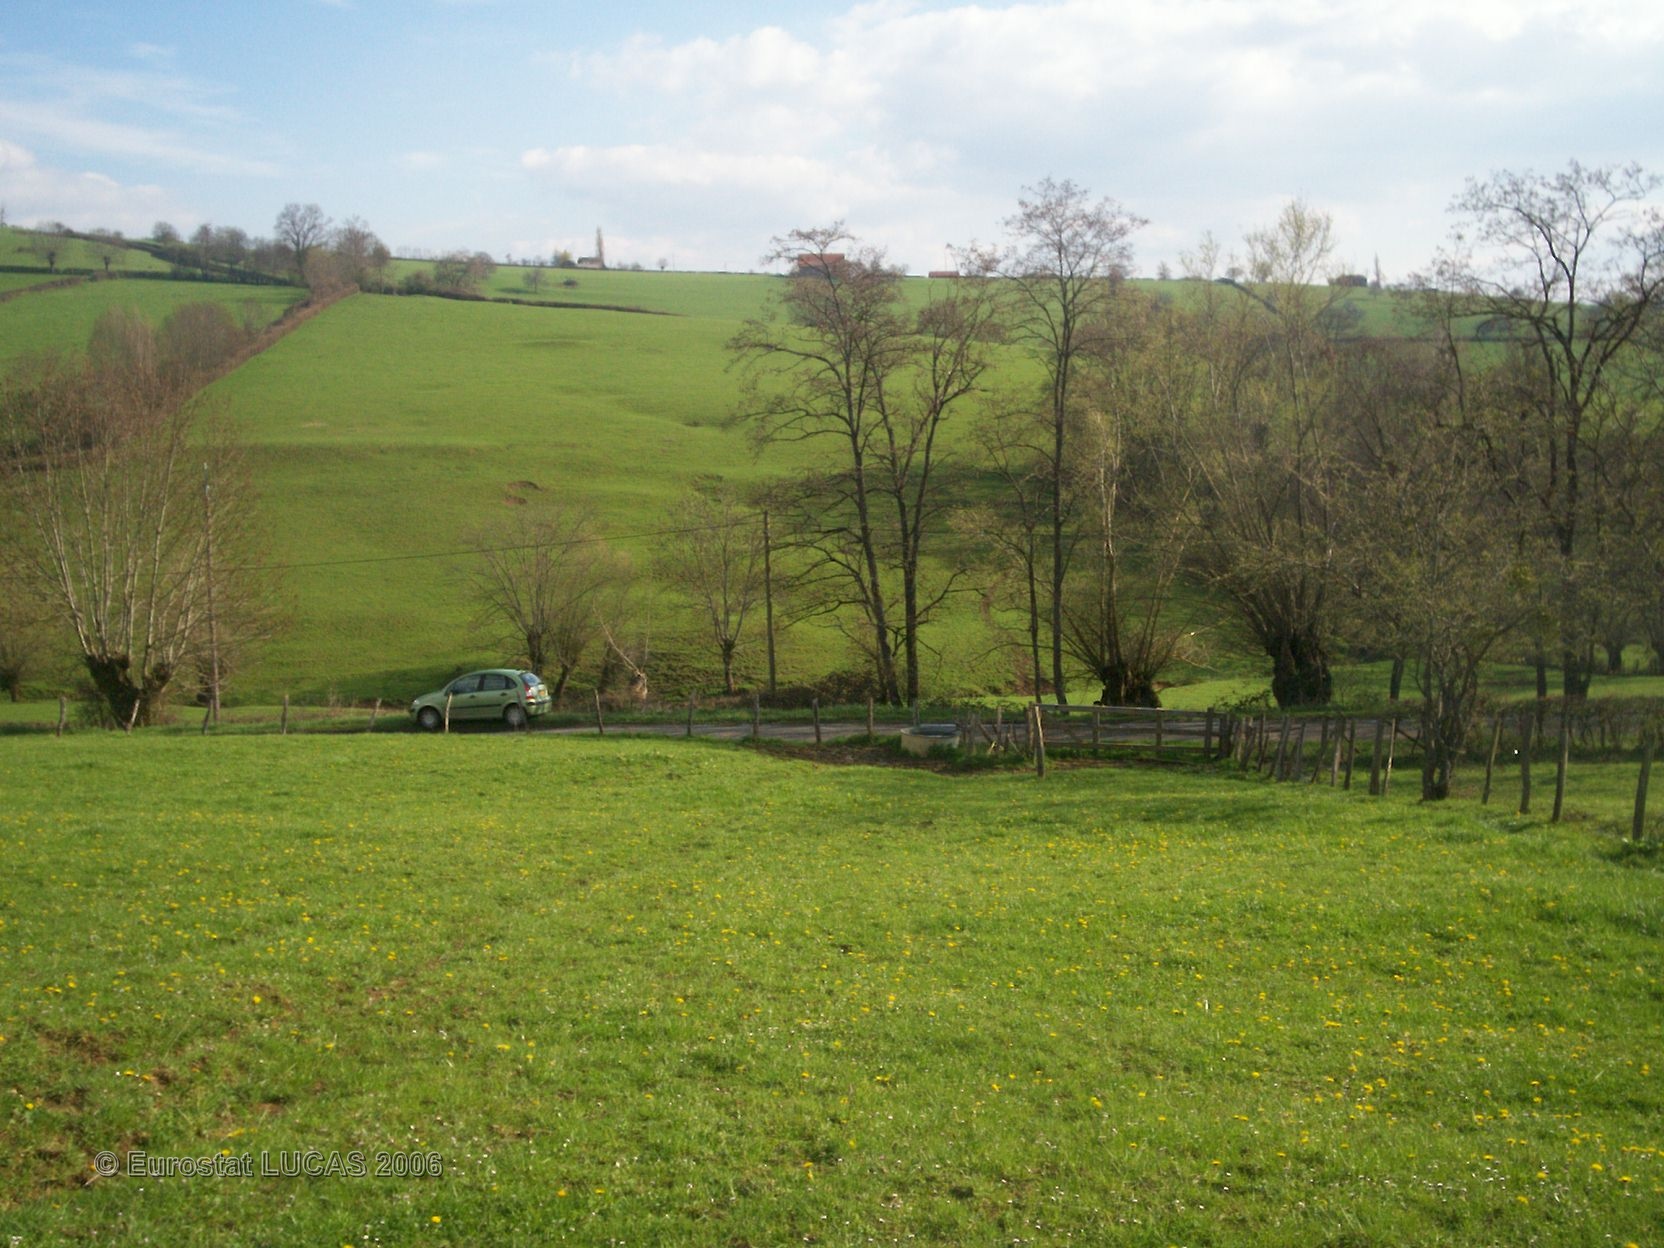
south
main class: Grassland
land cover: Grassland without tree/shrub cover
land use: Agriculture (excluding fallow land and kitchen gardens)
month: April
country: FR
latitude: 46.2260
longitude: 4.1280
